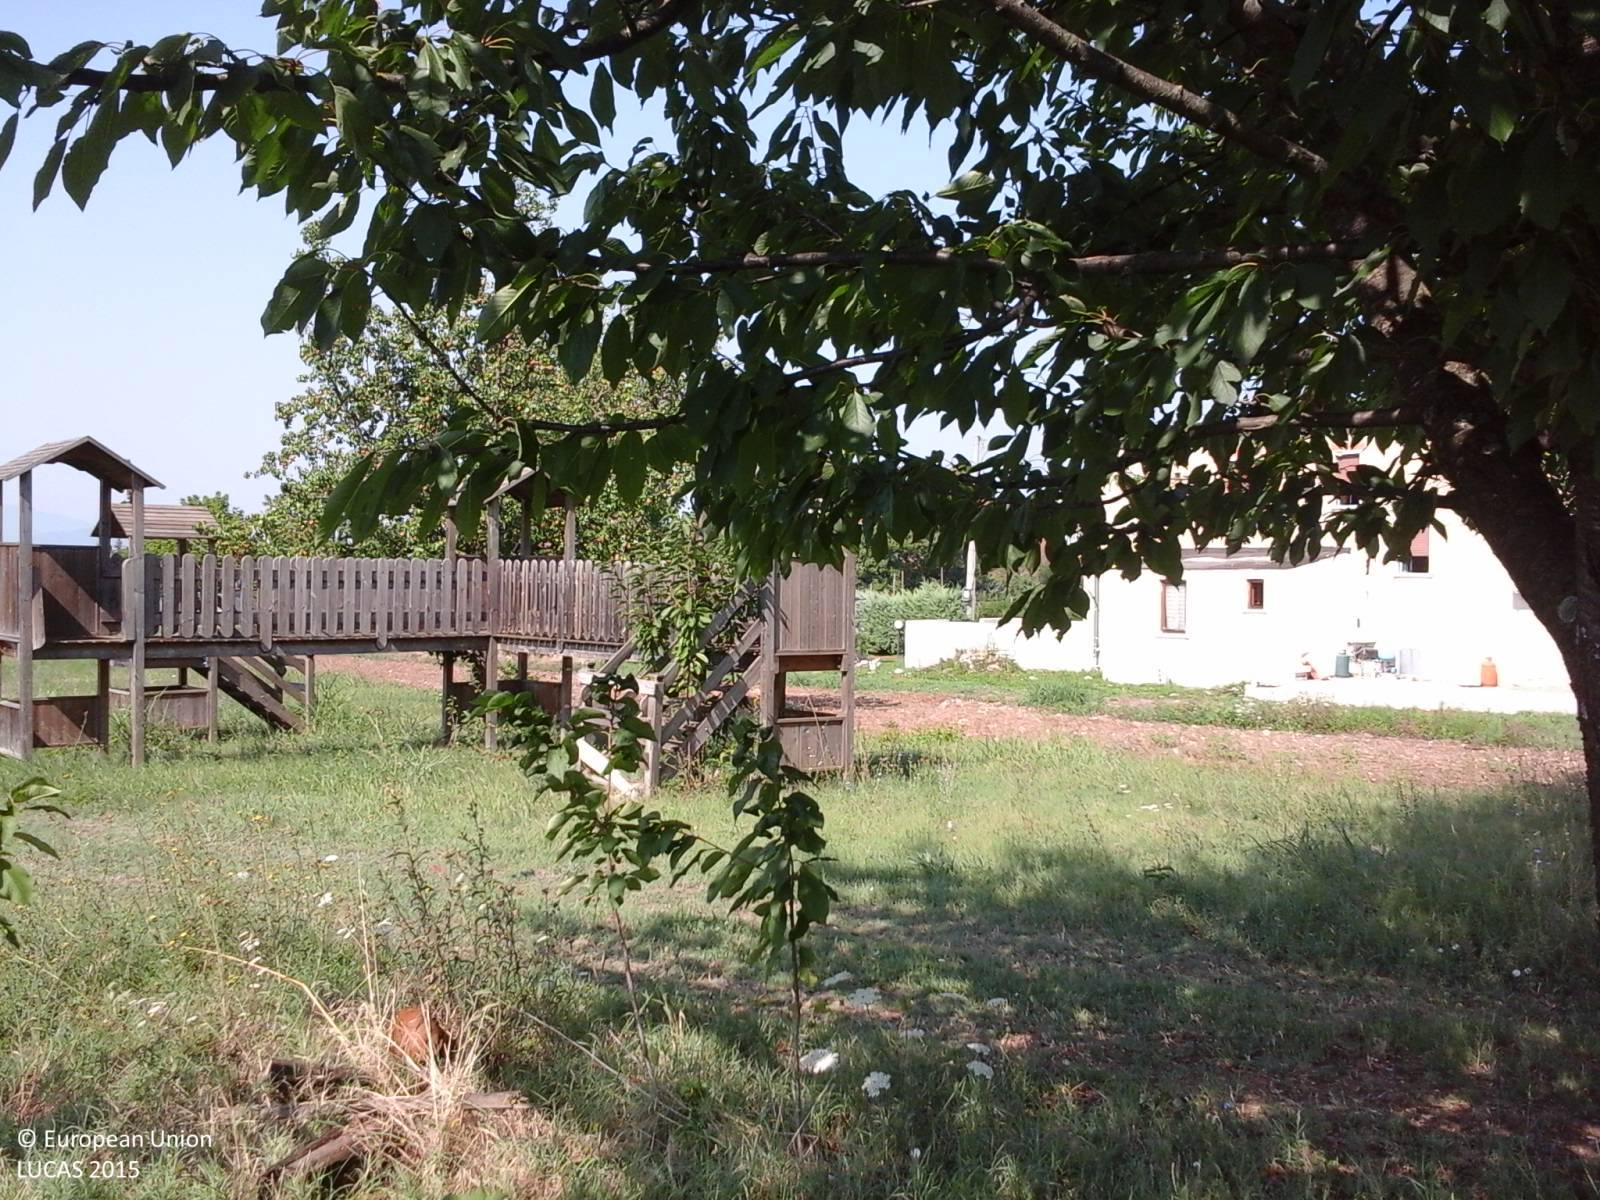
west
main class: Grassland
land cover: Grassland with sparse tree/shrub cover
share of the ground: > 75 %
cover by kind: herbaceous plants 95 %, broadleaved forest trees 5 %
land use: Amenities, museums, leisure
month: August
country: IT
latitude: 41.3474
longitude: 14.3698
